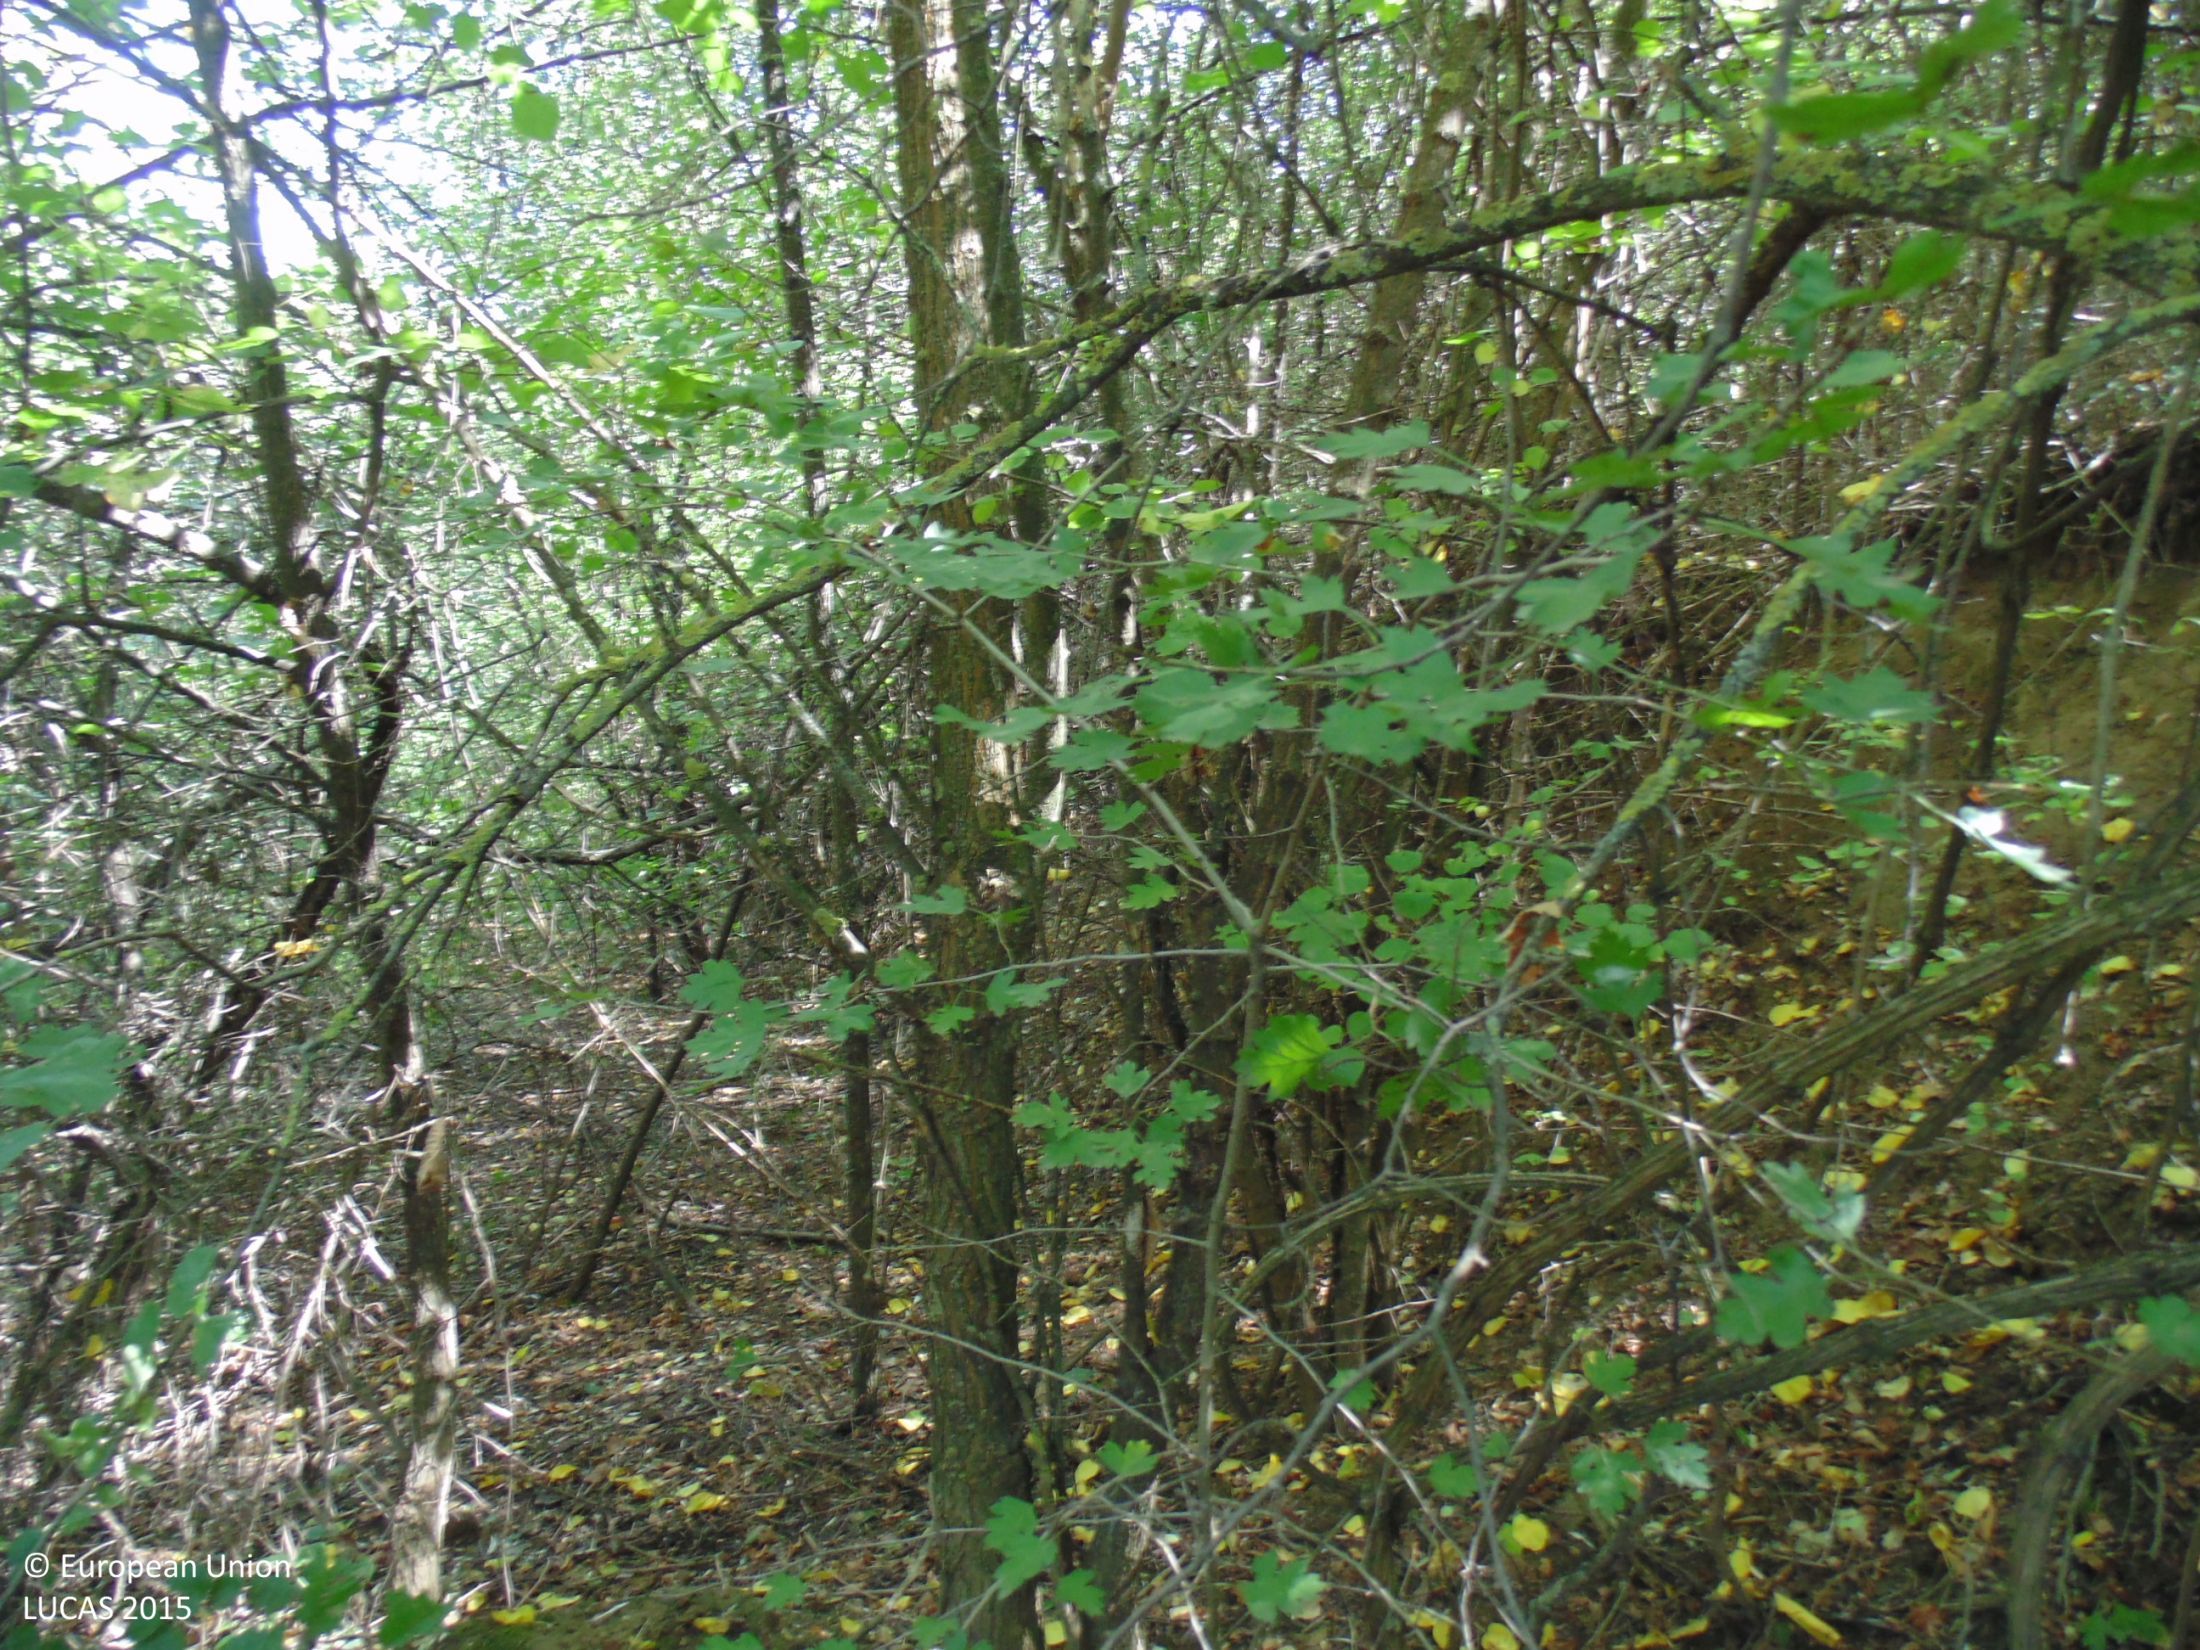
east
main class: Woodland
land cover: Broadleaved woodland
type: mesophytic deciduous forest
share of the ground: > 75 %
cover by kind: broadleaved forest trees 90 %, shrubs 5 %, unconsolidated bare surface 5 %
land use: Forestry
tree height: > 5 m
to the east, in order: Broadleaved woodland; Electric lines; Broadleaved woodland; Arable land (only in case pi)
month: September
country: BG
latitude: 44.1162
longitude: 26.9802
